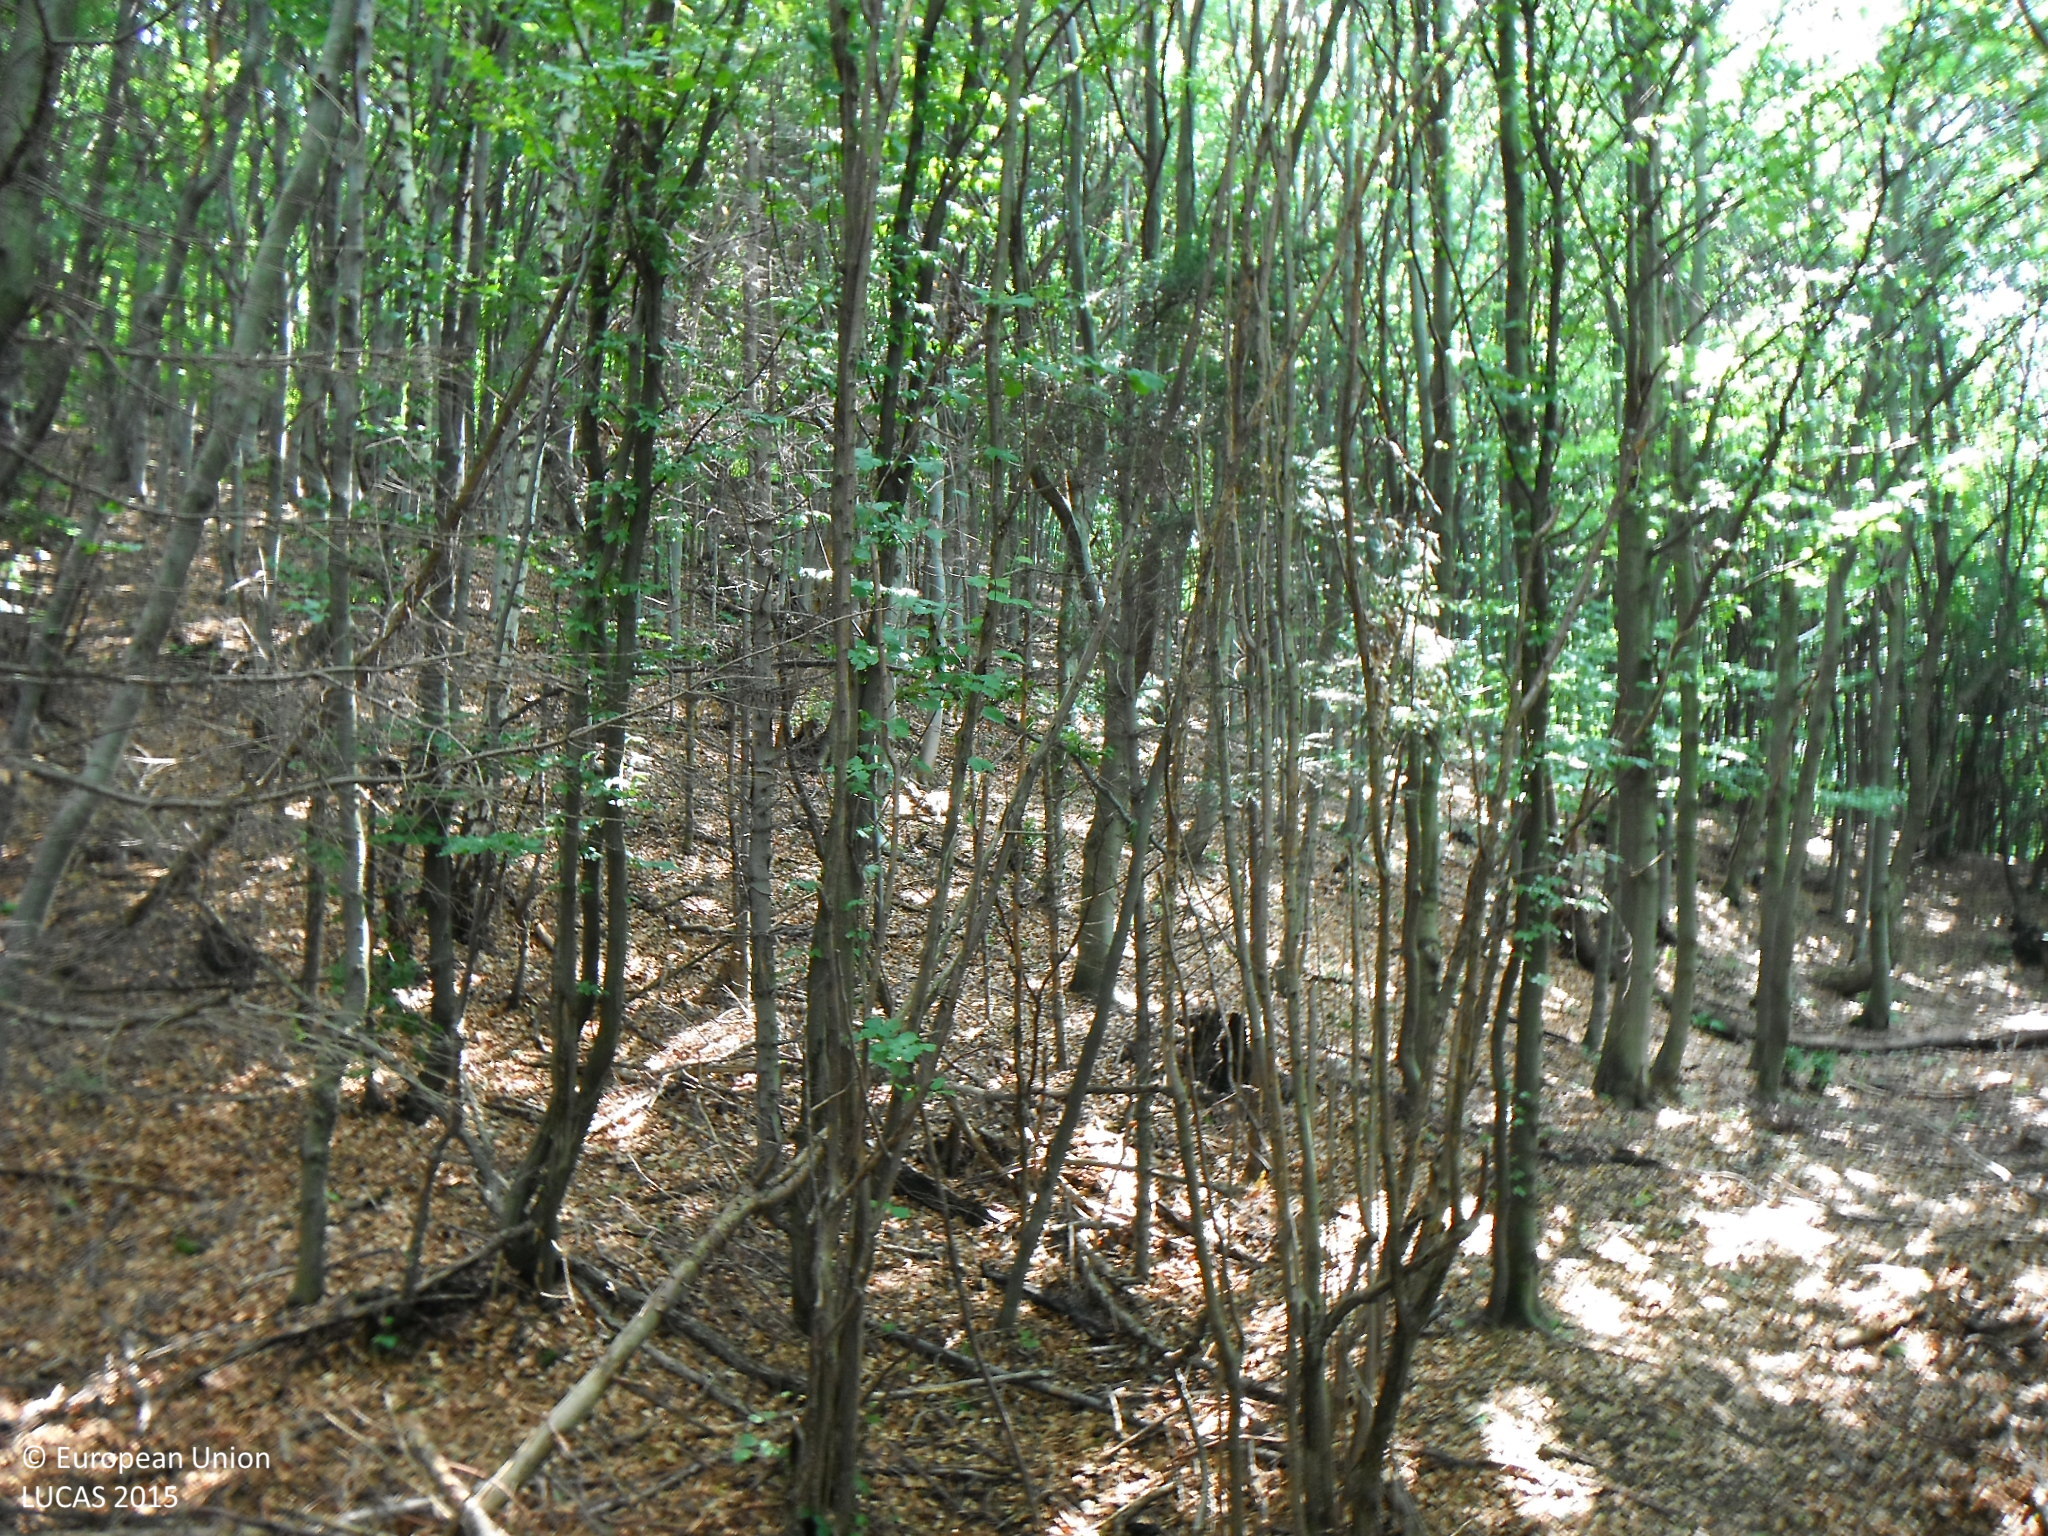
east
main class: Woodland
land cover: Broadleaved woodland
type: beech forest
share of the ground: > 75 %
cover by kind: broadleaved forest trees 85 %, coniferous forest trees 15 %
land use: Forestry
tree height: > 5 m
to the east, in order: Broadleaved woodland
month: July
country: SK
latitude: 49.4225
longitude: 21.2821
